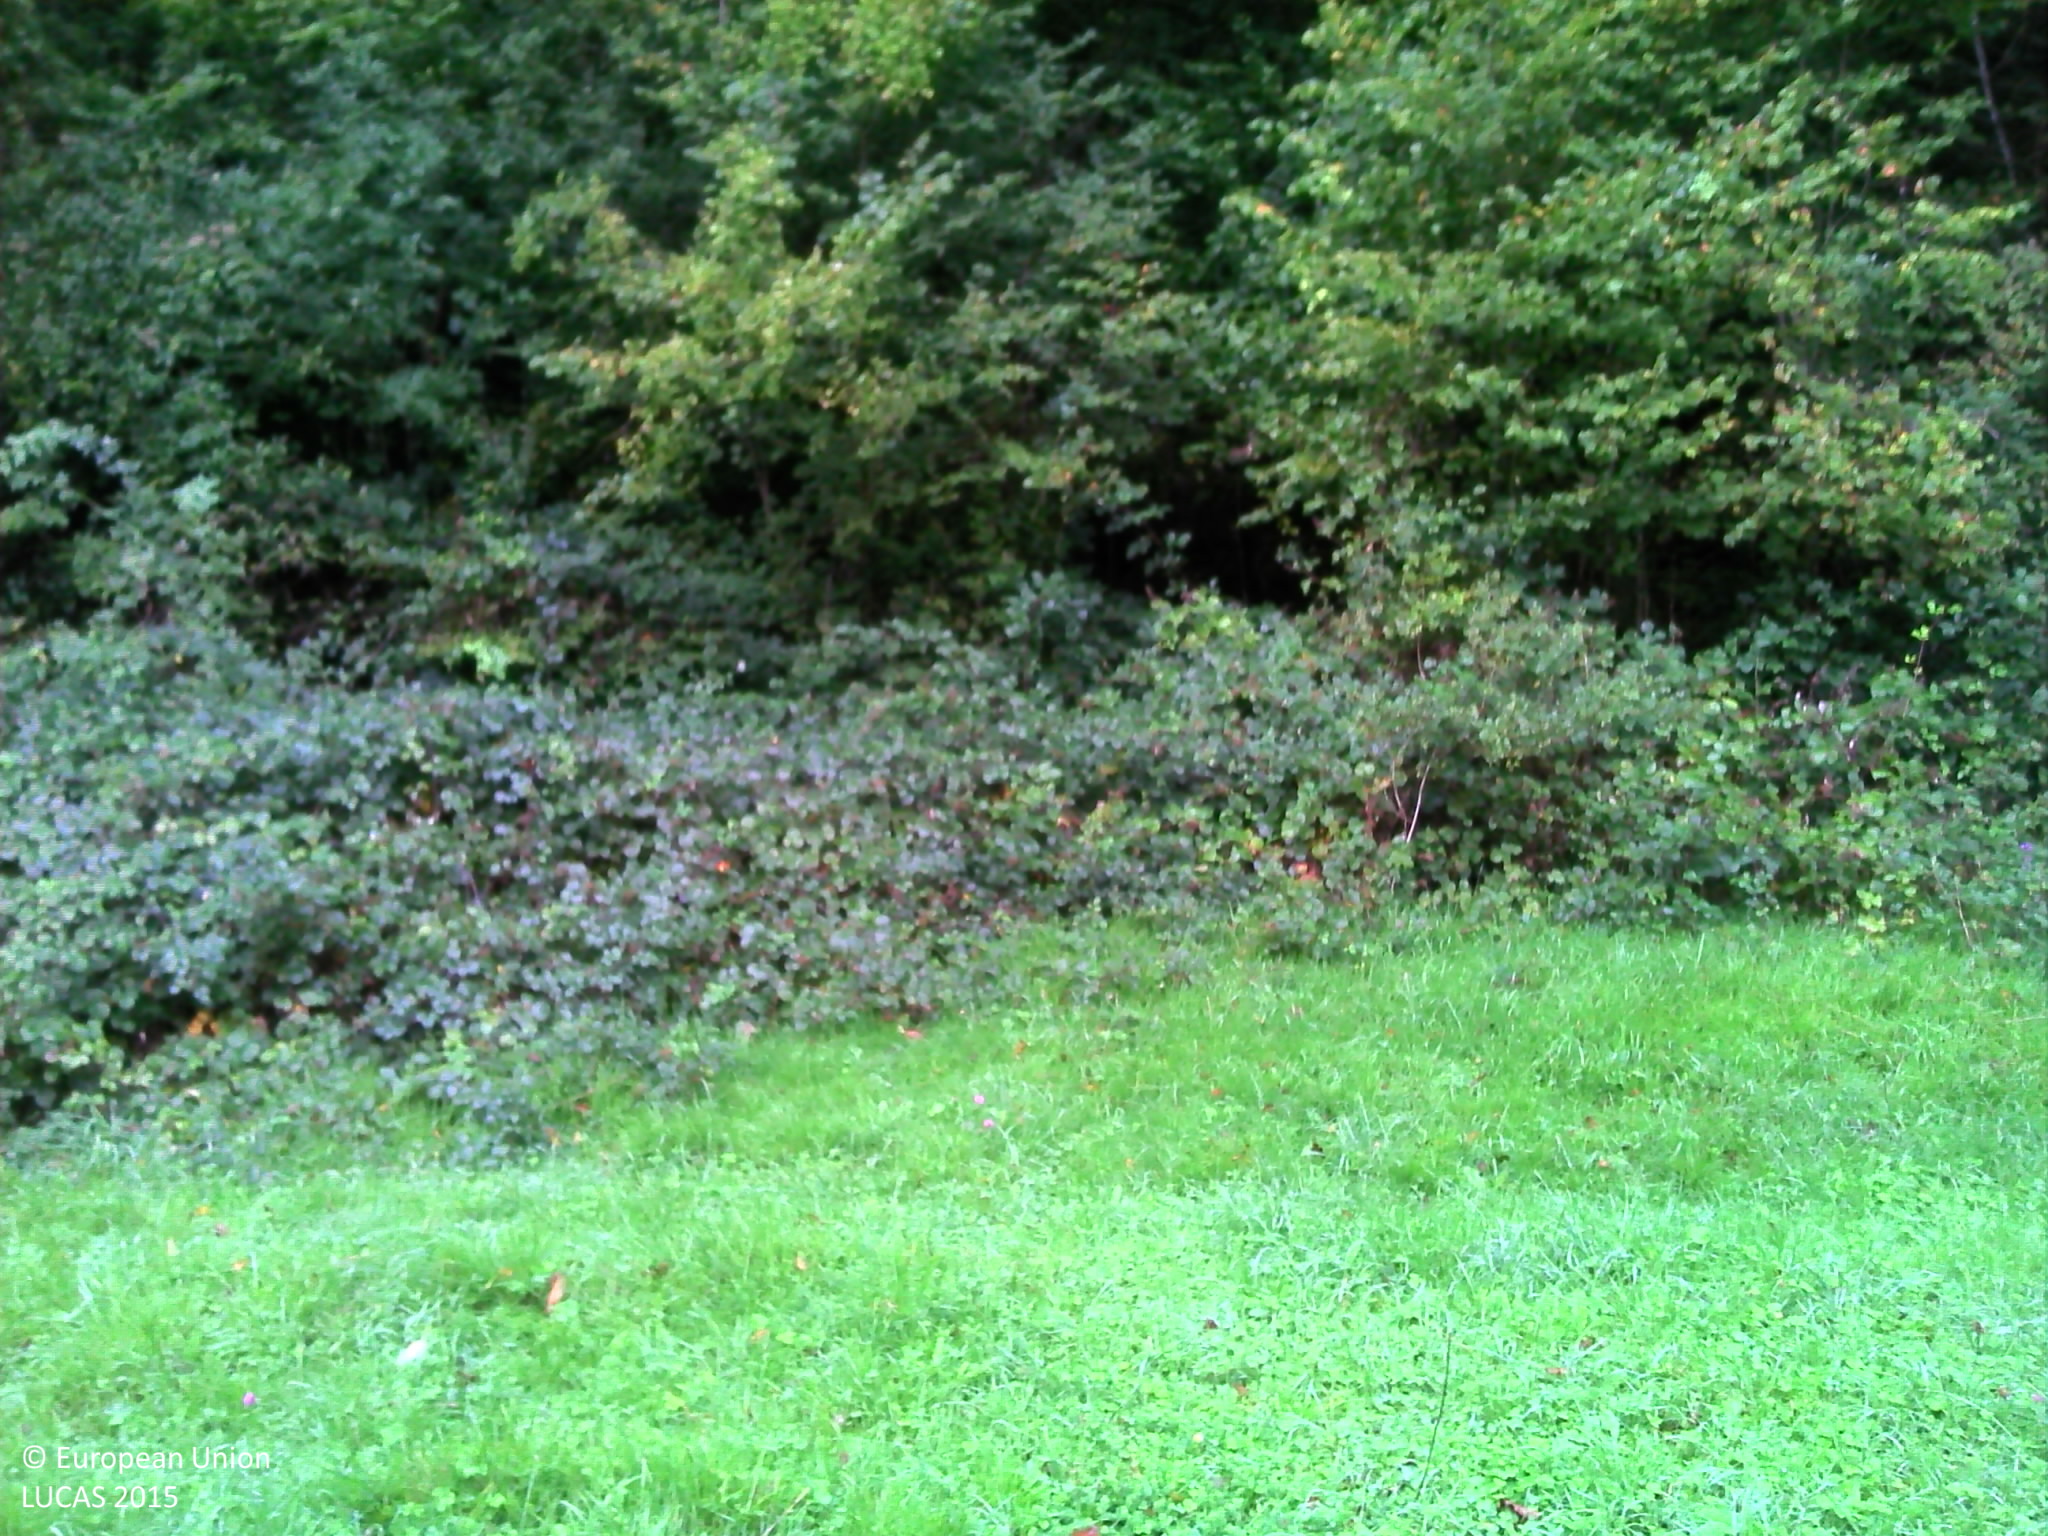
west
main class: Grassland
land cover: Grassland without tree/shrub cover
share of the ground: > 75 %
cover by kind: herbaceous plants 100 %
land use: Agriculture (excluding fallow land and kitchen gardens)
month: September
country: FR
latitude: 47.0895
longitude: 4.7708
